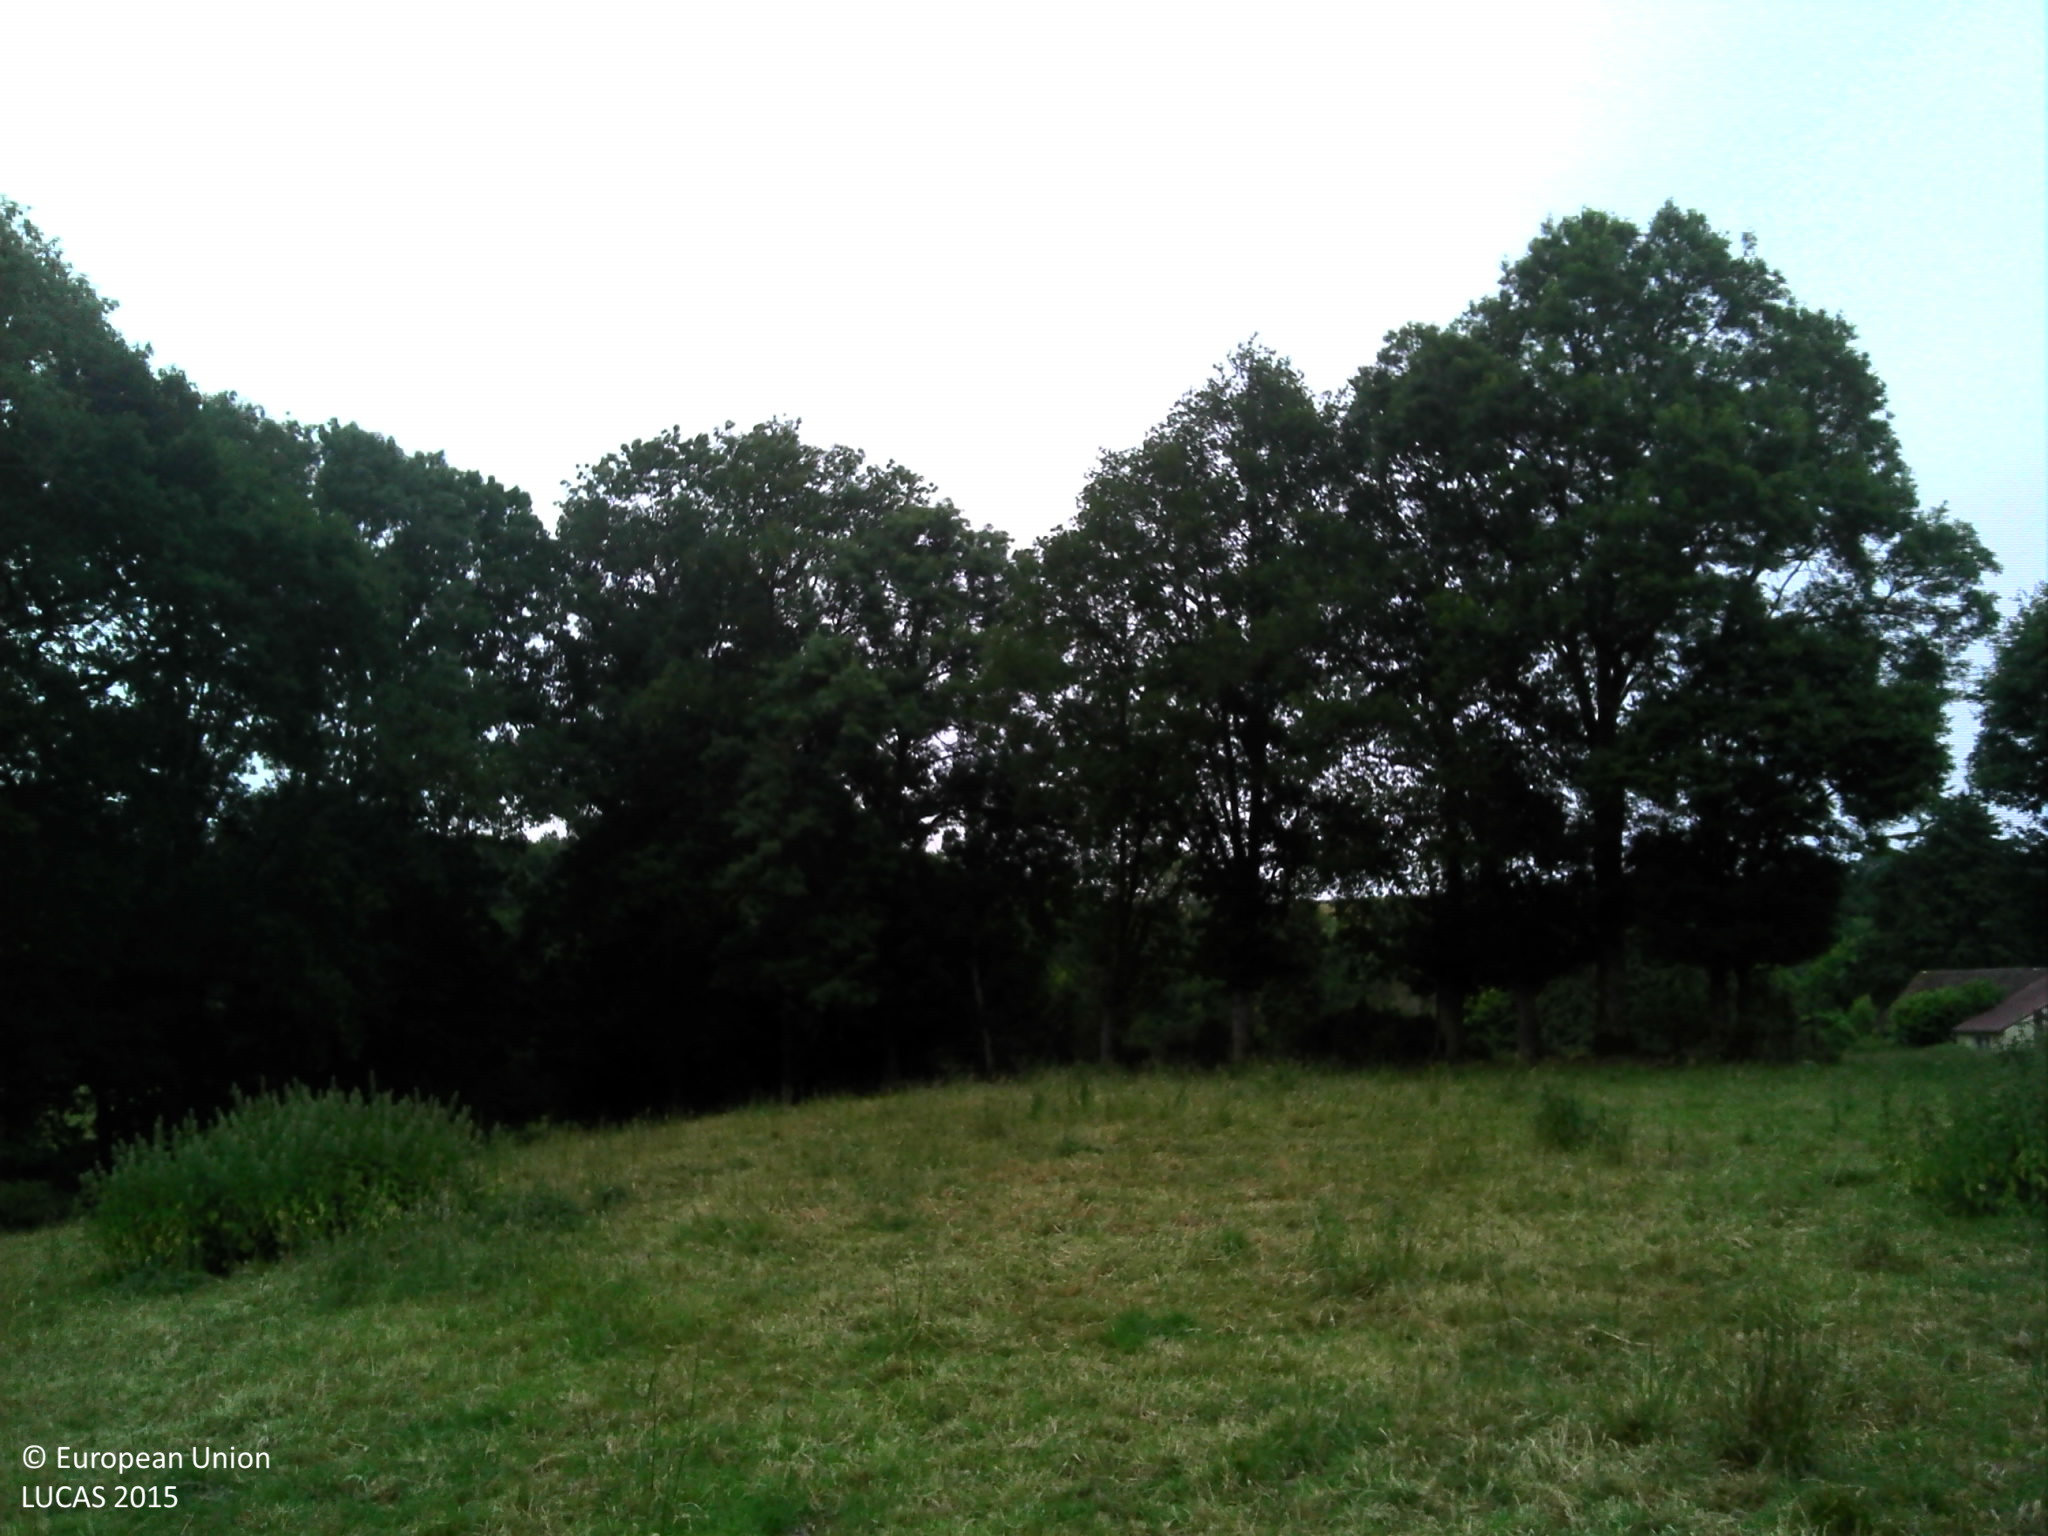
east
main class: Grassland
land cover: Grassland without tree/shrub cover
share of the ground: > 75 %
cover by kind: herbaceous plants 100 %
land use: Agriculture (excluding fallow land and kitchen gardens)
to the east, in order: Grassland without tree/shrub cover; Fences; Lines of trees; Fences; Grassland without tree/shrub cover; Fences; Single bushes/trees; Abandoned hedges; Grassland without tree/shrub cover; Broadleaved woodland; Inland fresh running water
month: June
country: FR
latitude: 48.3073
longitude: -0.0471
